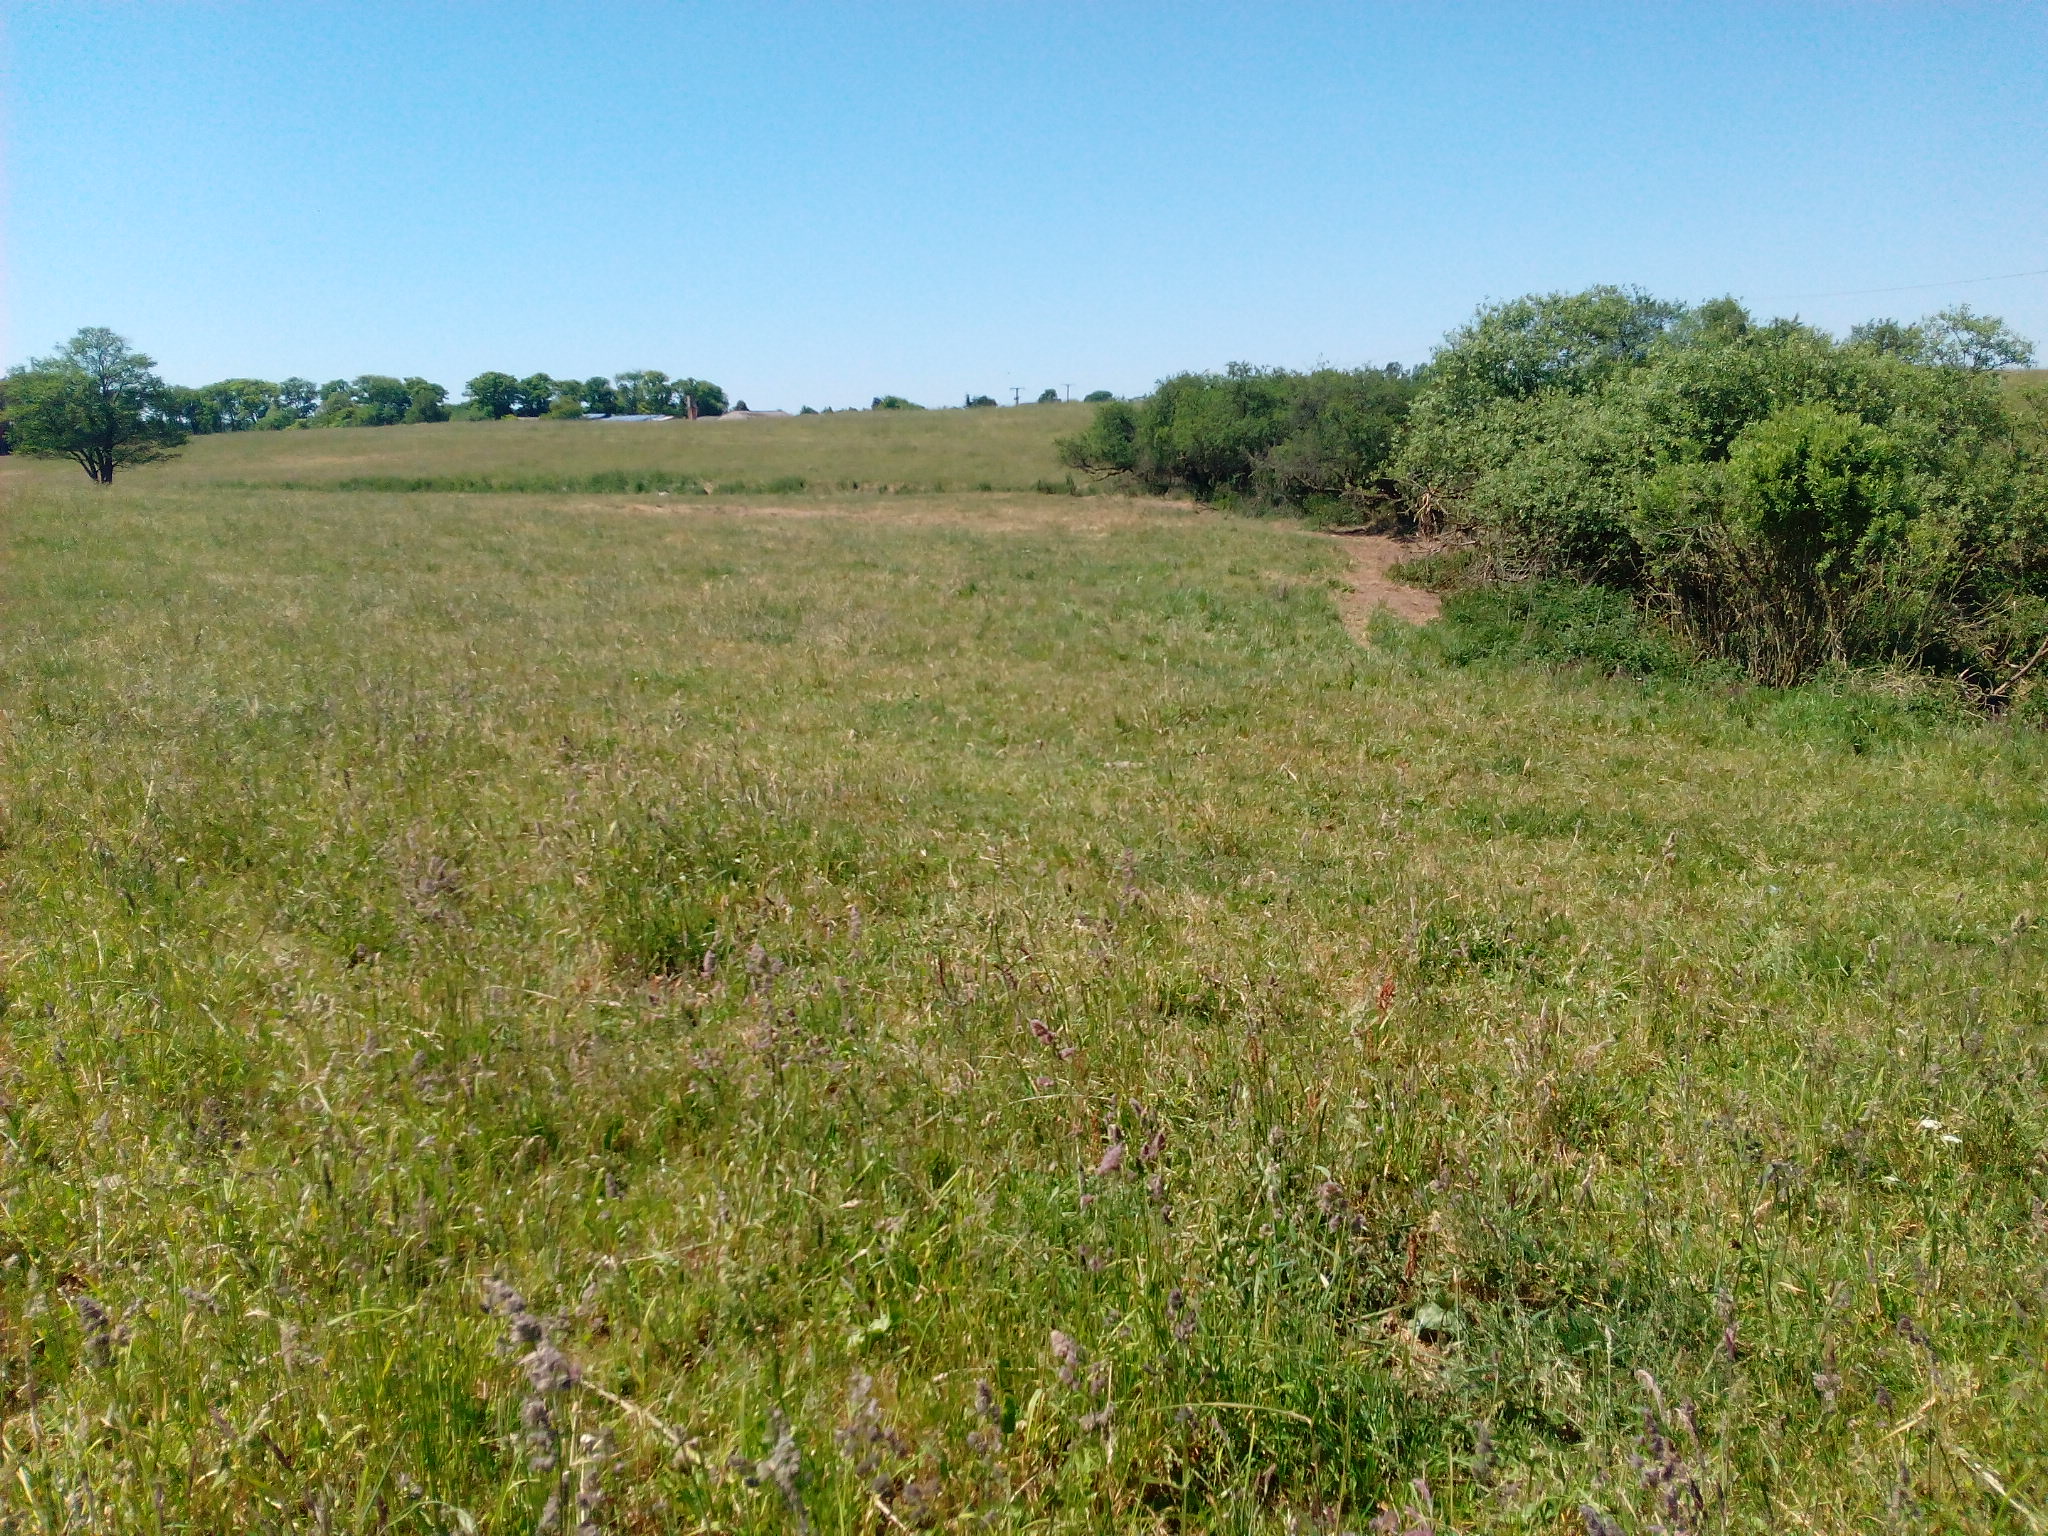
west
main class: Grassland
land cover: Grassland without tree/shrub cover
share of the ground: > 75 %
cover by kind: herbaceous plants 95 %, shrubs 5 %
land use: Agriculture (excluding fallow land and kitchen gardens)
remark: Harvested field
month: June
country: DE
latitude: 53.1693
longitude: 13.5753
